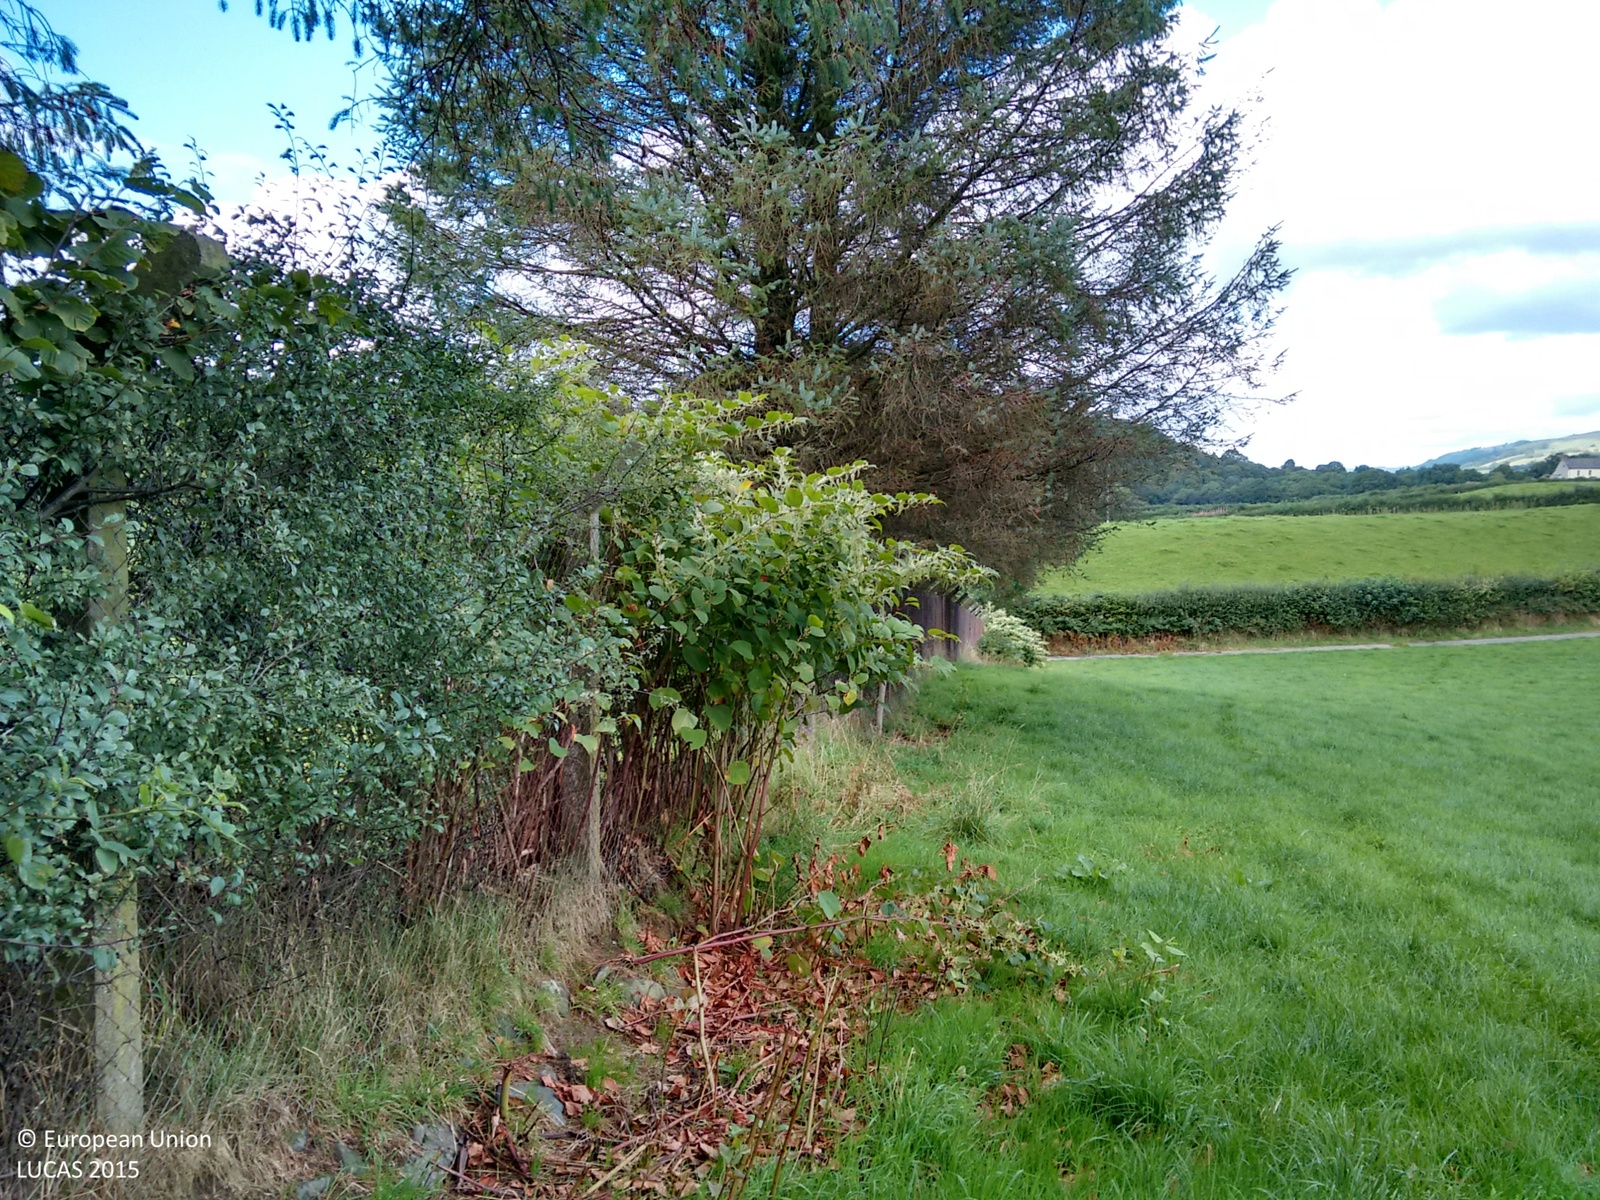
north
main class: Grassland
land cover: Grassland without tree/shrub cover
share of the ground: > 75 %
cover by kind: herbaceous plants 100 %
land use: Agriculture (excluding fallow land and kitchen gardens)
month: September
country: GB
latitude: 52.1214
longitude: -4.0437
